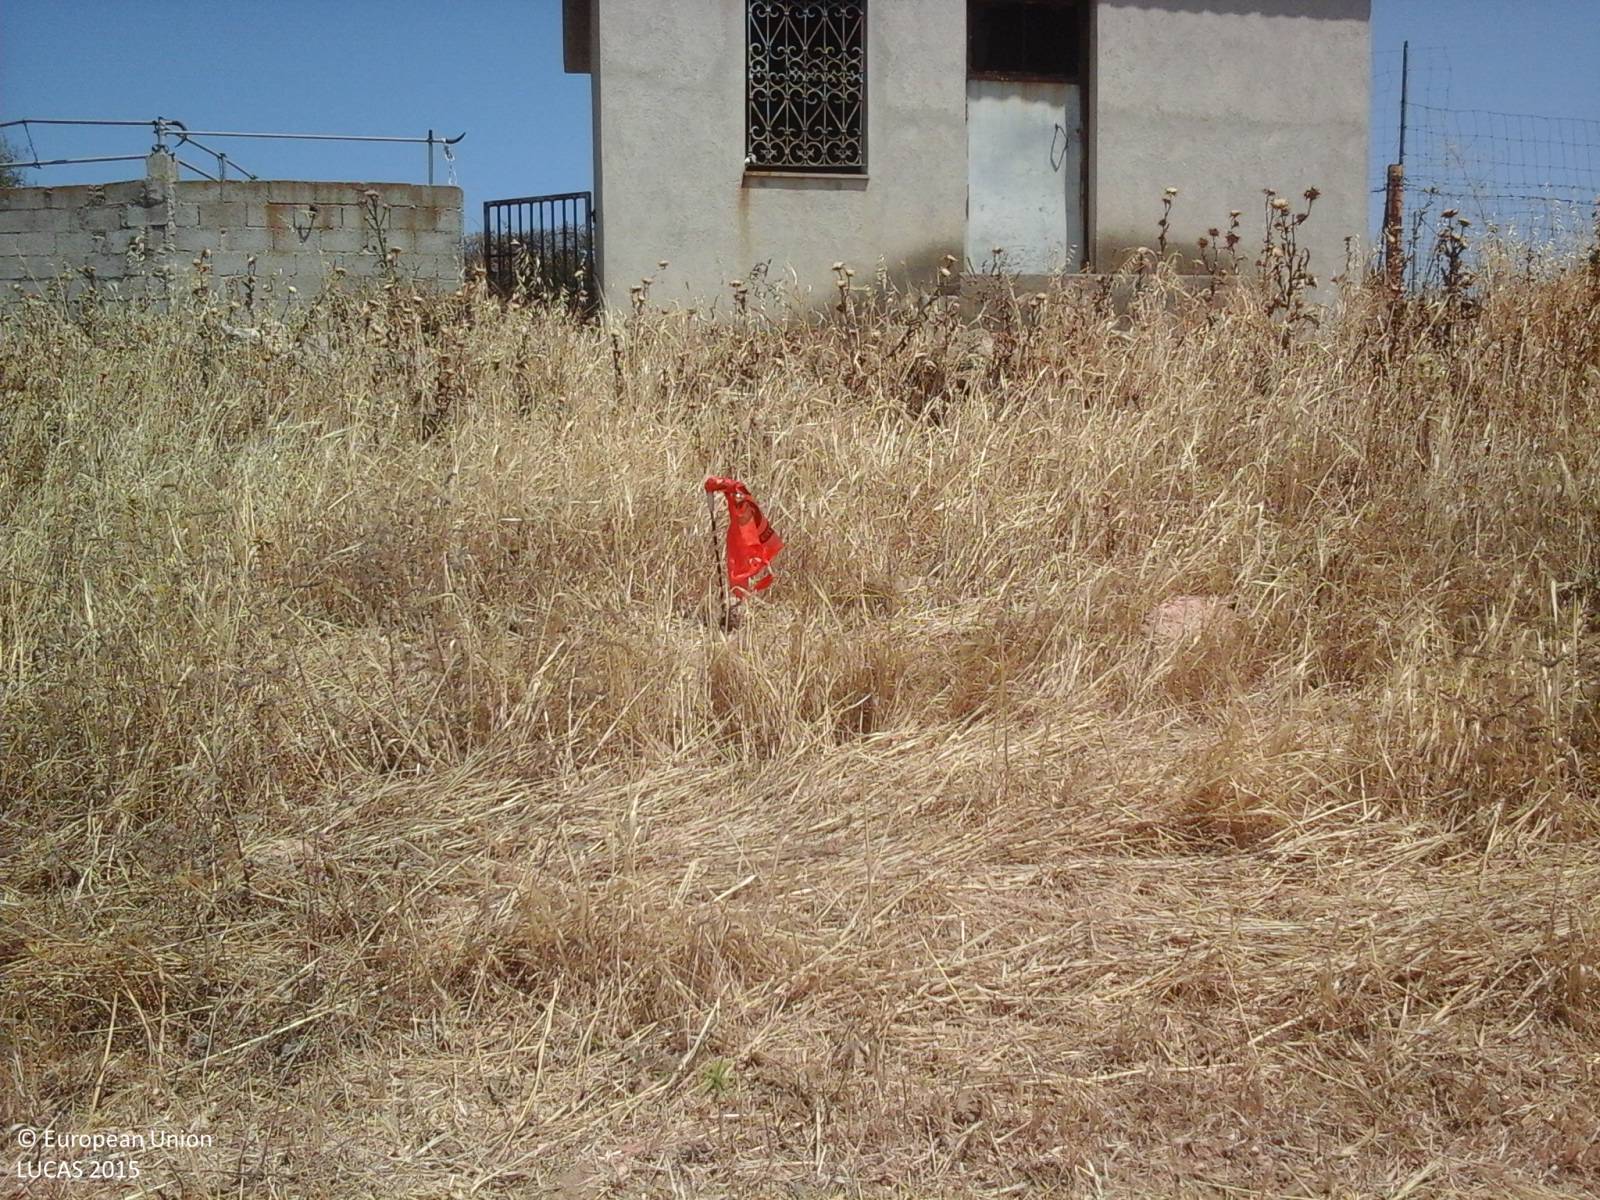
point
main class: Grassland
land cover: Grassland without tree/shrub cover
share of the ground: > 75 %
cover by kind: herbaceous plants 95 %, unconsolidated bare surface 5 %
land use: Agriculture (excluding fallow land and kitchen gardens)
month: June
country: IT
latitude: 40.6648
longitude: 9.6351
